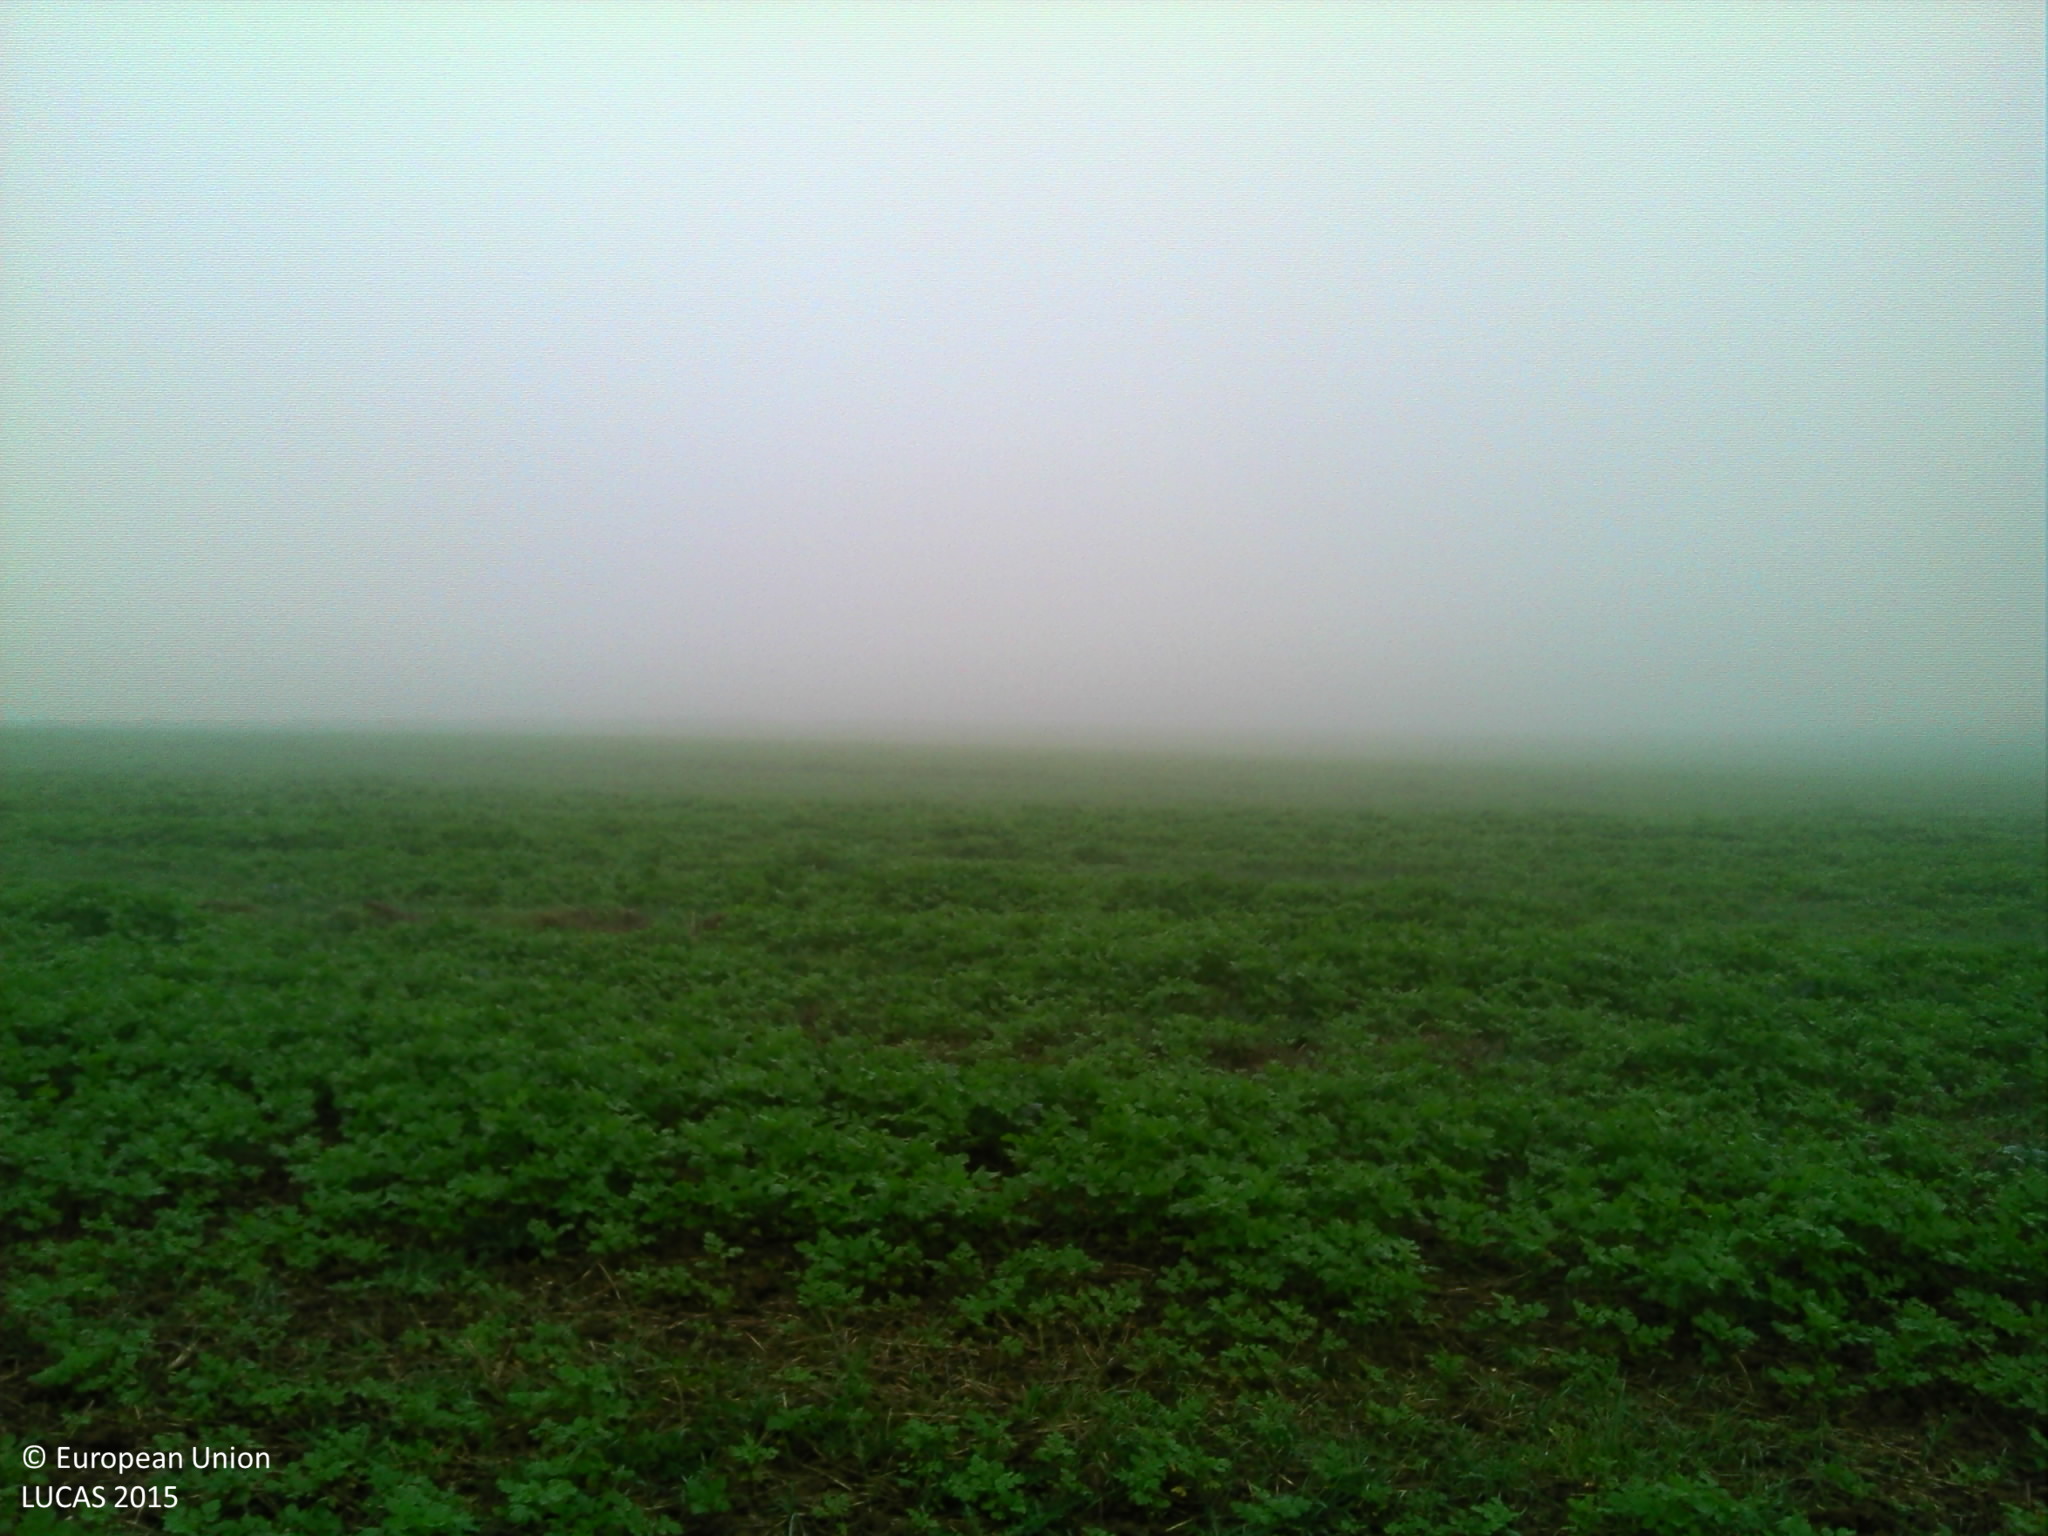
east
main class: Cropland
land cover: Other fibre and oleaginous crops
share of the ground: > 75 %
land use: Agriculture (excluding fallow land and kitchen gardens)
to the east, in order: Other fibre and oleaginous crops
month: October
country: FR
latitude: 49.7951
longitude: 4.0629
